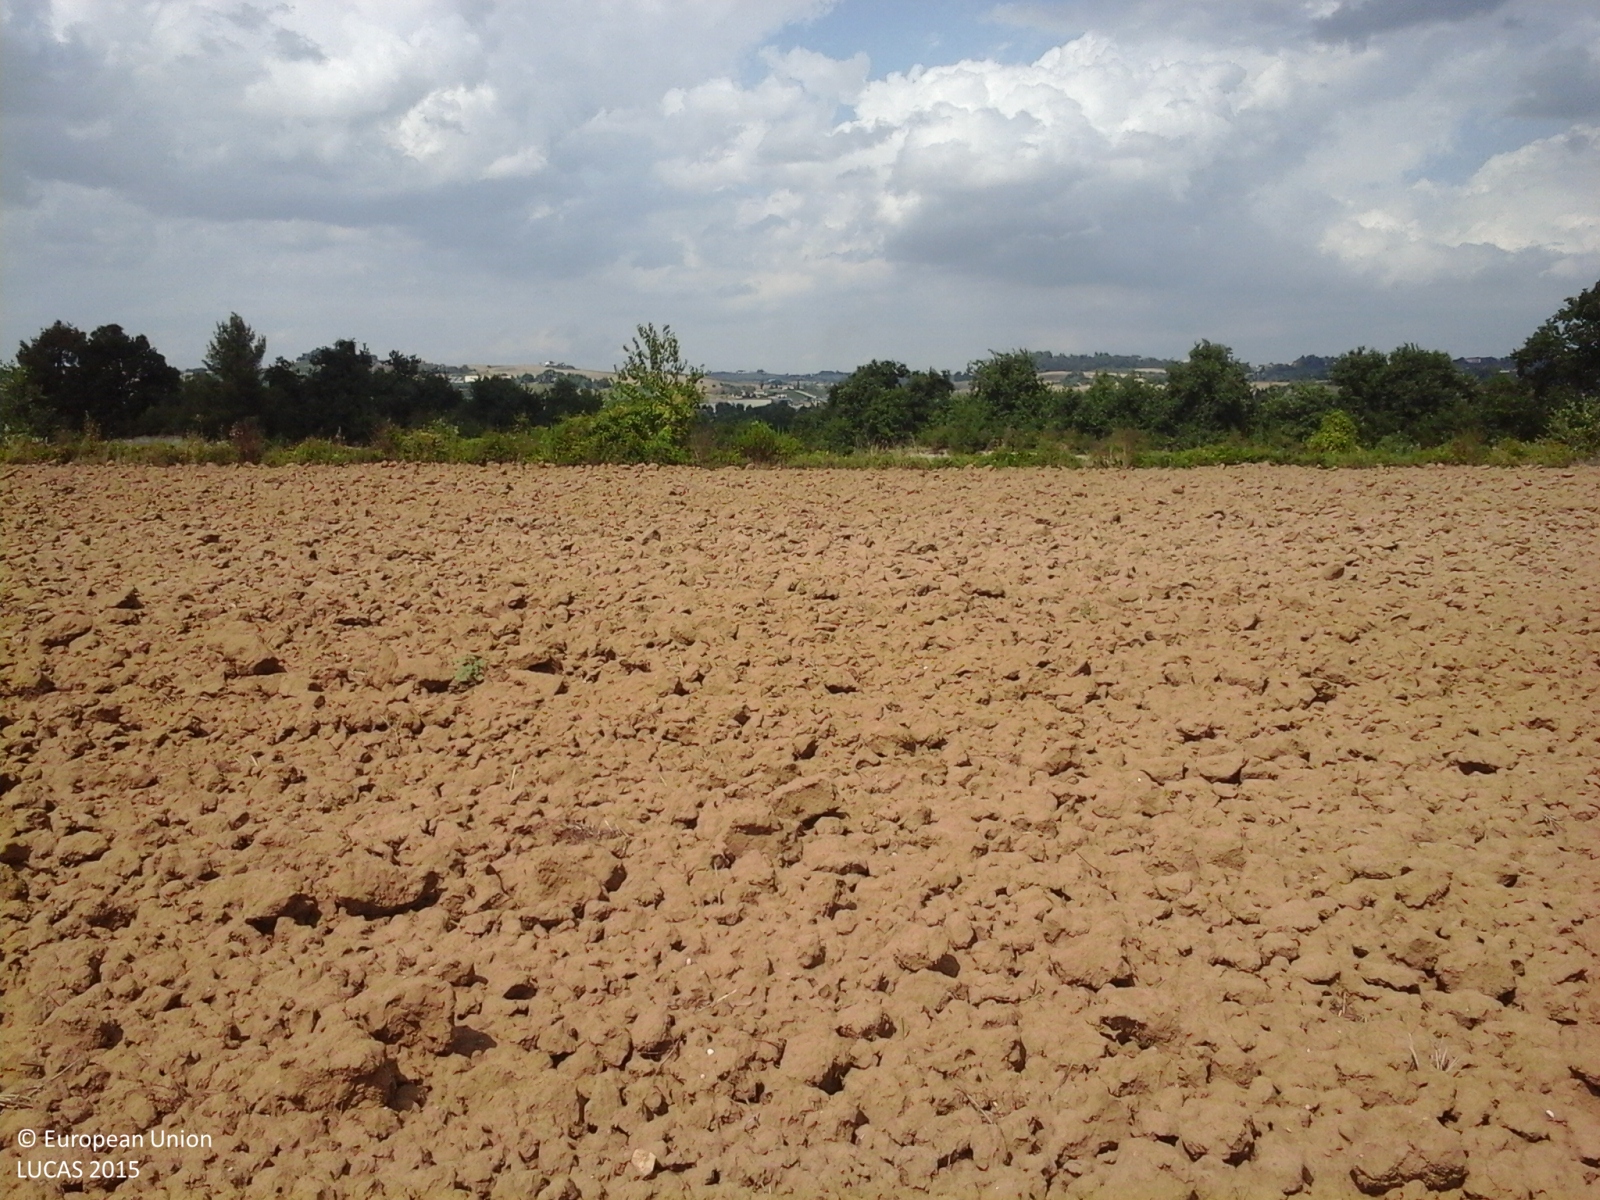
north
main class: Cropland
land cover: Durum wheat
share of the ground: < 10 %
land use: Agriculture (excluding fallow land and kitchen gardens)
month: August
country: IT
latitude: 43.4897
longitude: 13.1700
